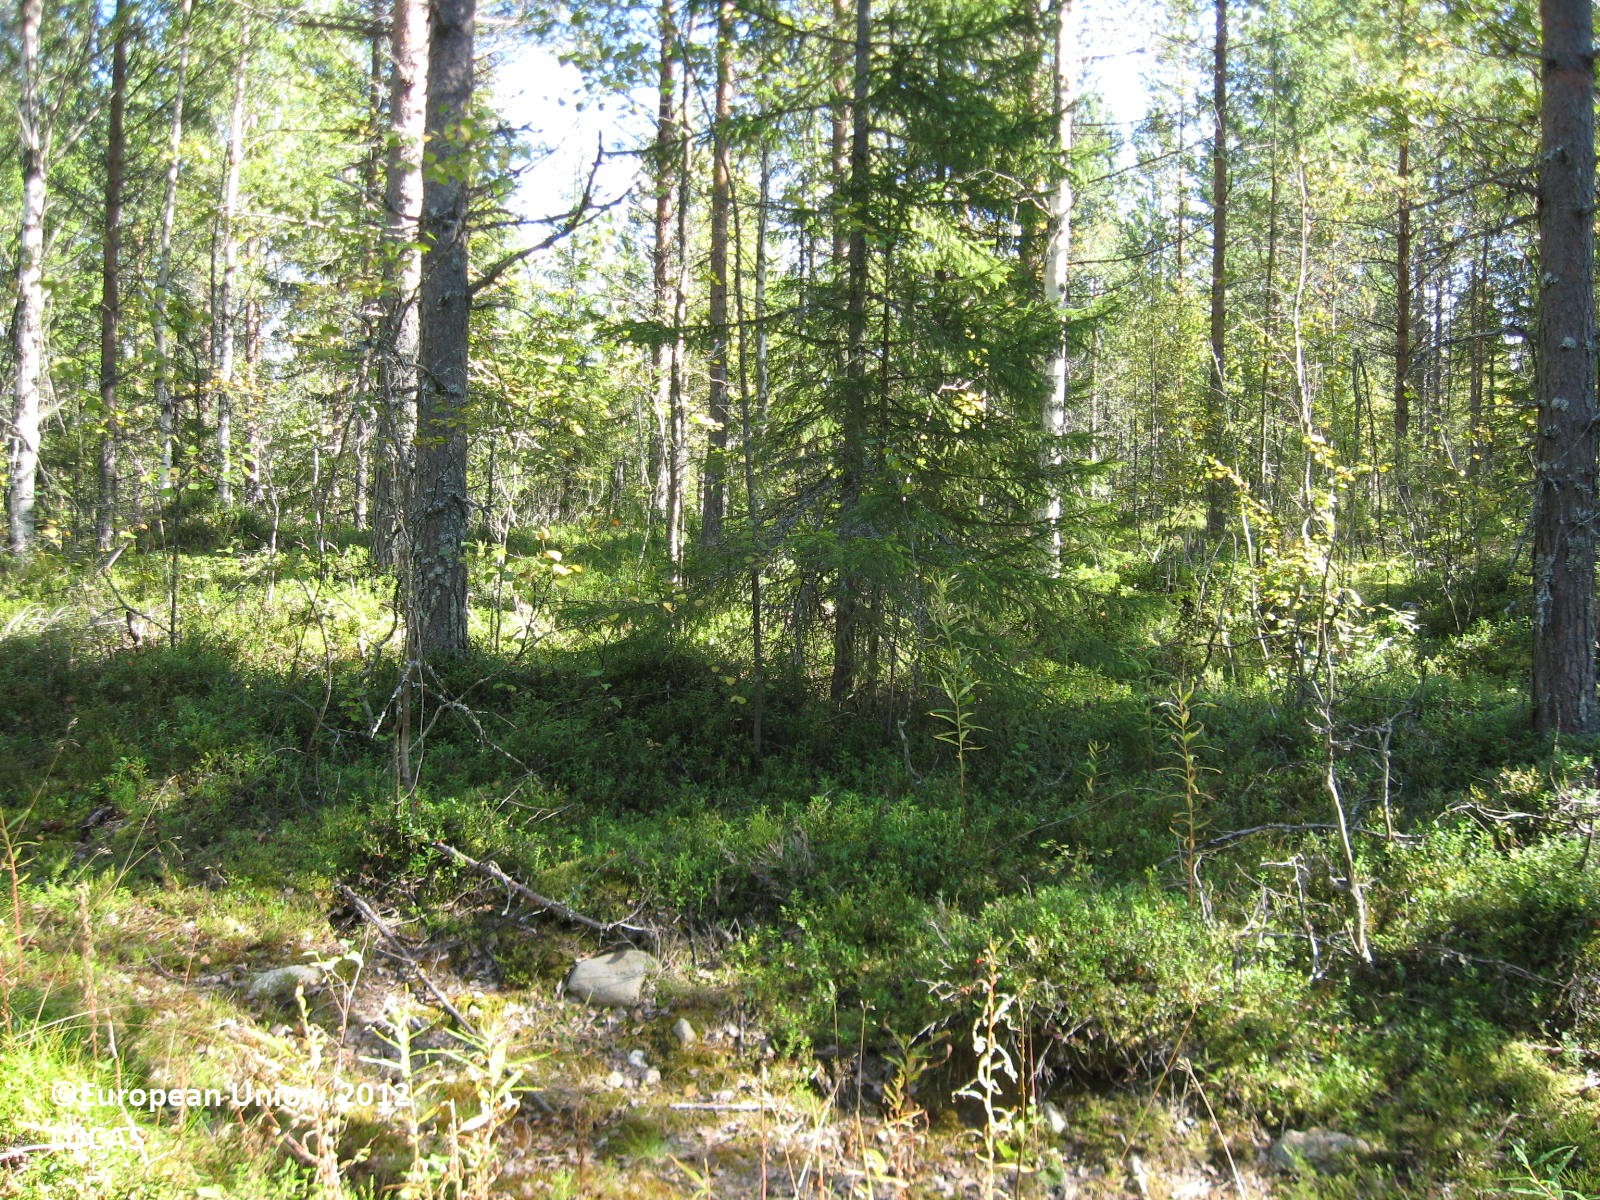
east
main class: Woodland
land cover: Pine dominated mixed woodland
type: boreal forest
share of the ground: > 75 %
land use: Forestry
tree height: > 5 m
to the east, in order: Pine dominated mixed woodland; Ditches and canals; Pine dominated coniferous woodland; Ditches and canals; Pine dominated coniferous woodland
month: August
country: FI
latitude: 63.8378
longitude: 29.3877
